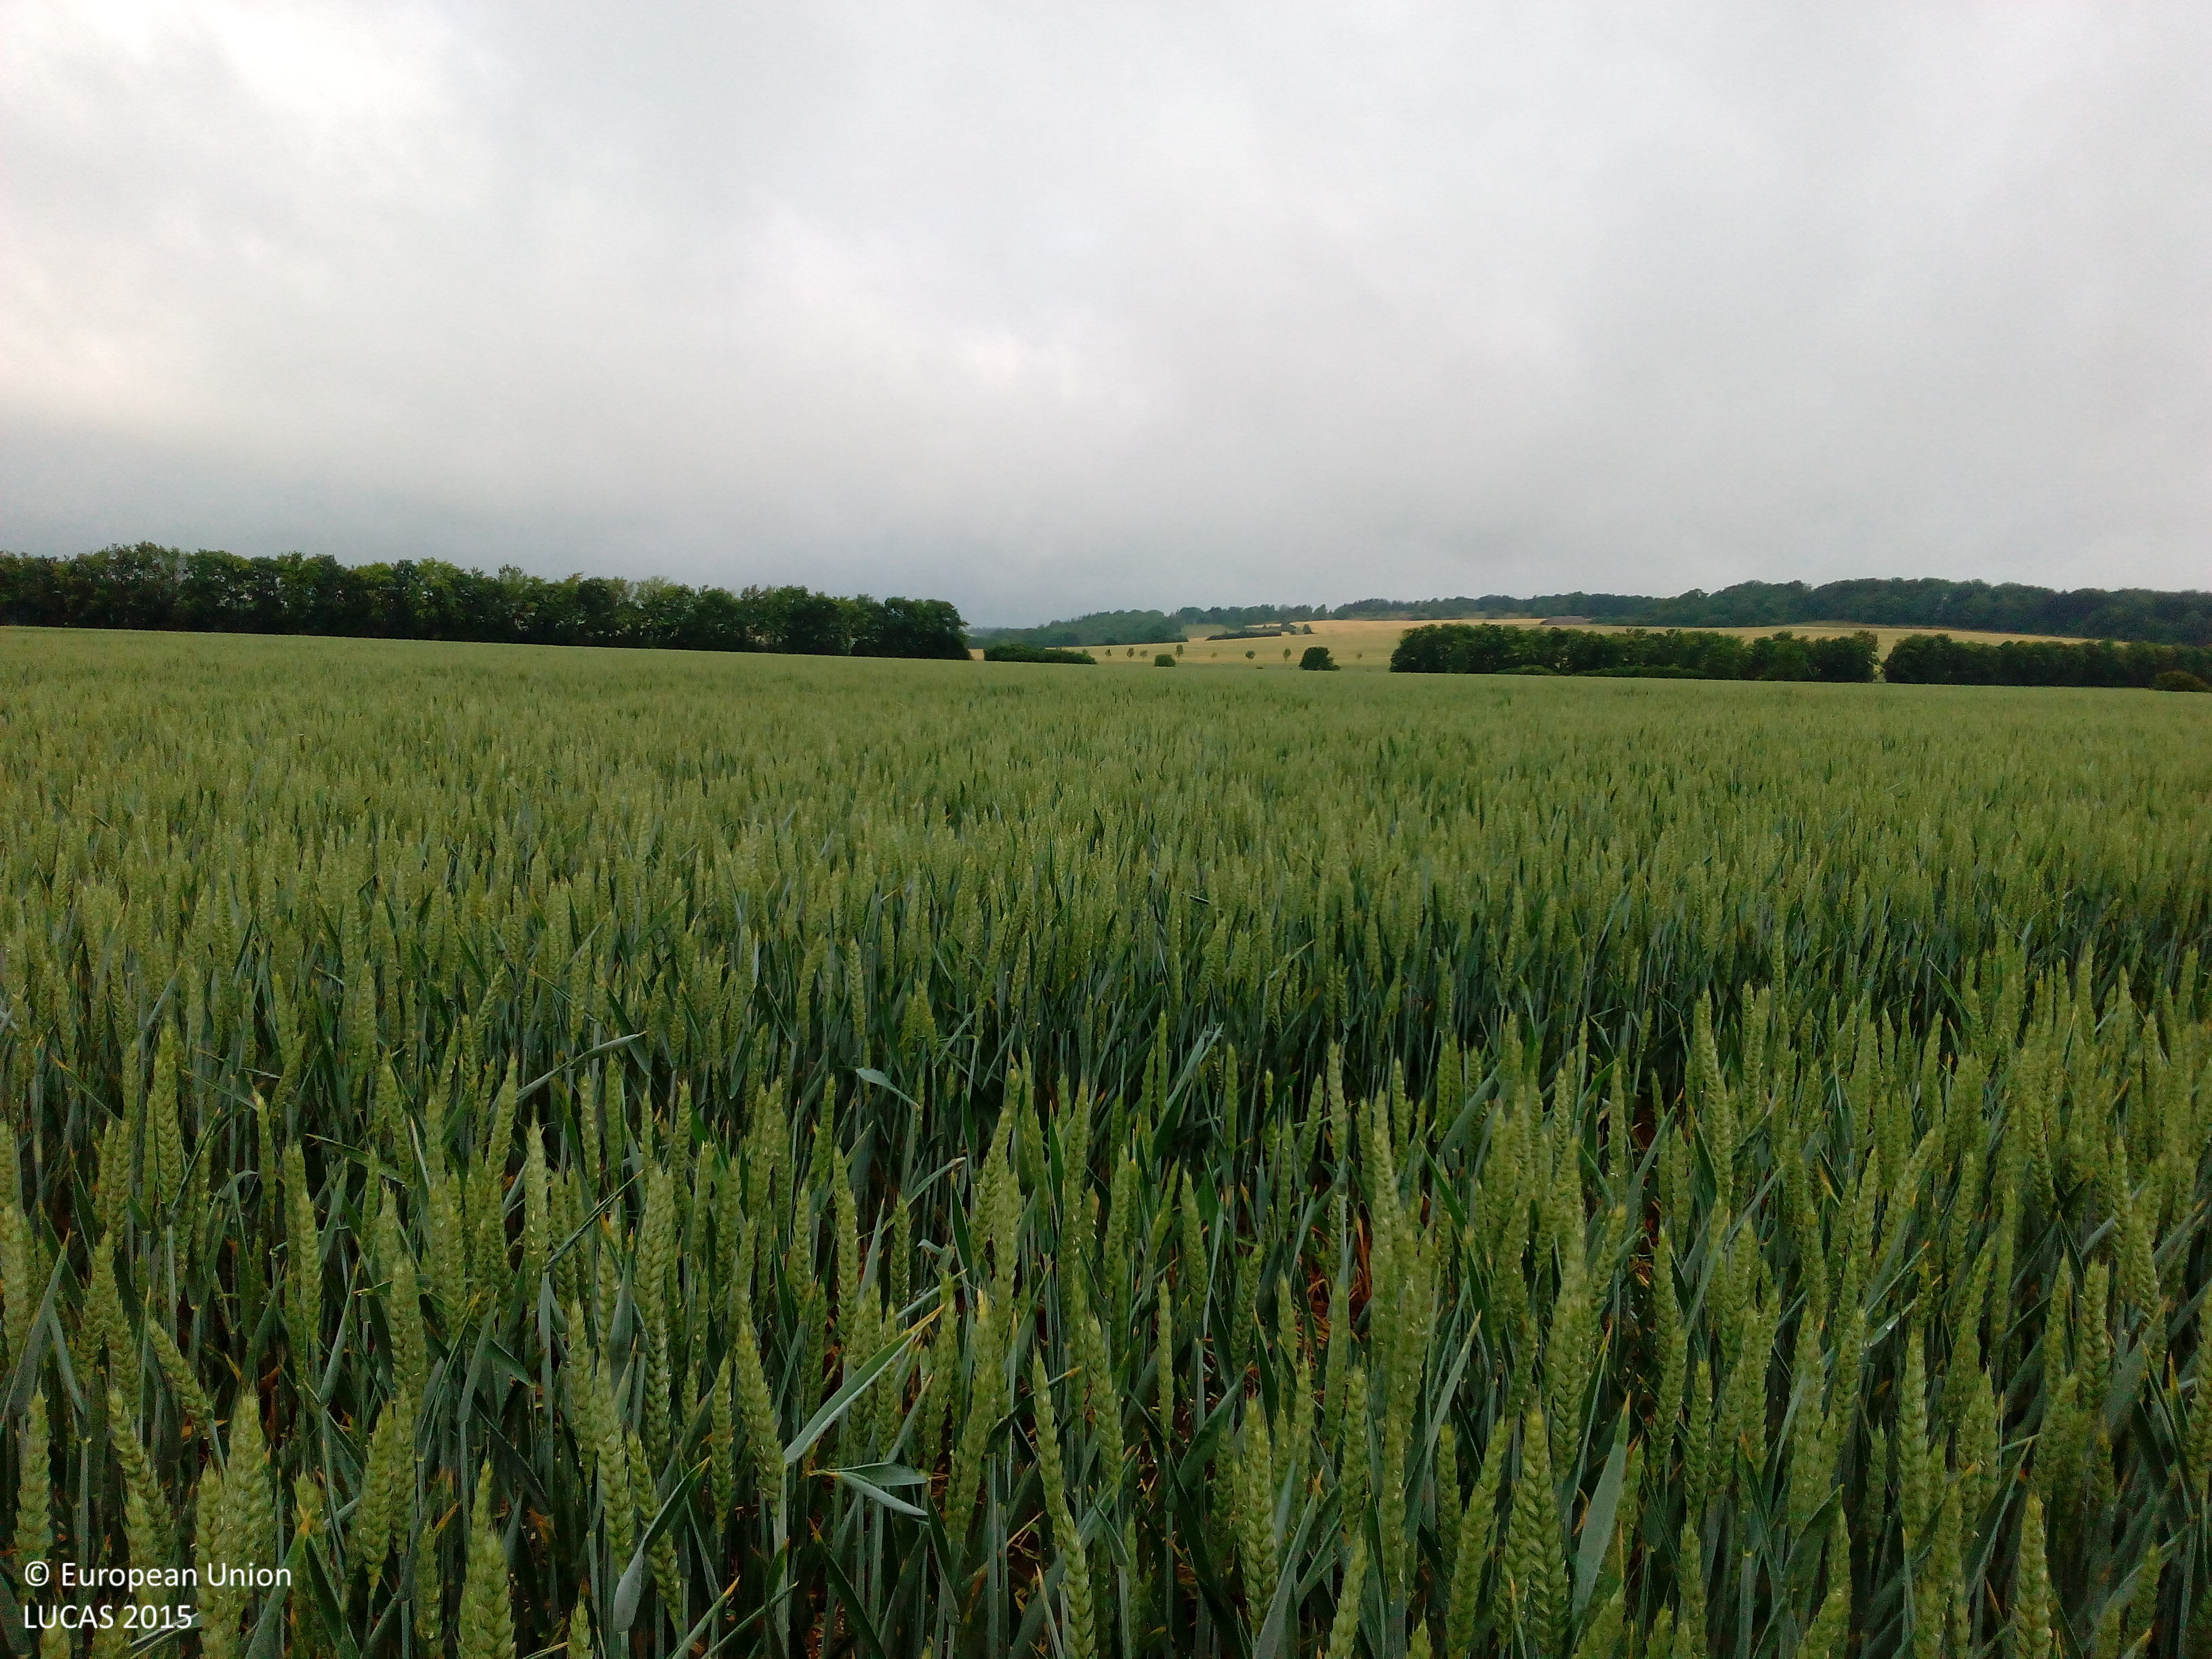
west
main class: Cropland
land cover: Common wheat
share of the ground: > 75 %
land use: Agriculture (excluding fallow land and kitchen gardens)
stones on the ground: < 10 %
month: June
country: DE
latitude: 50.8406
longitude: 11.4339
